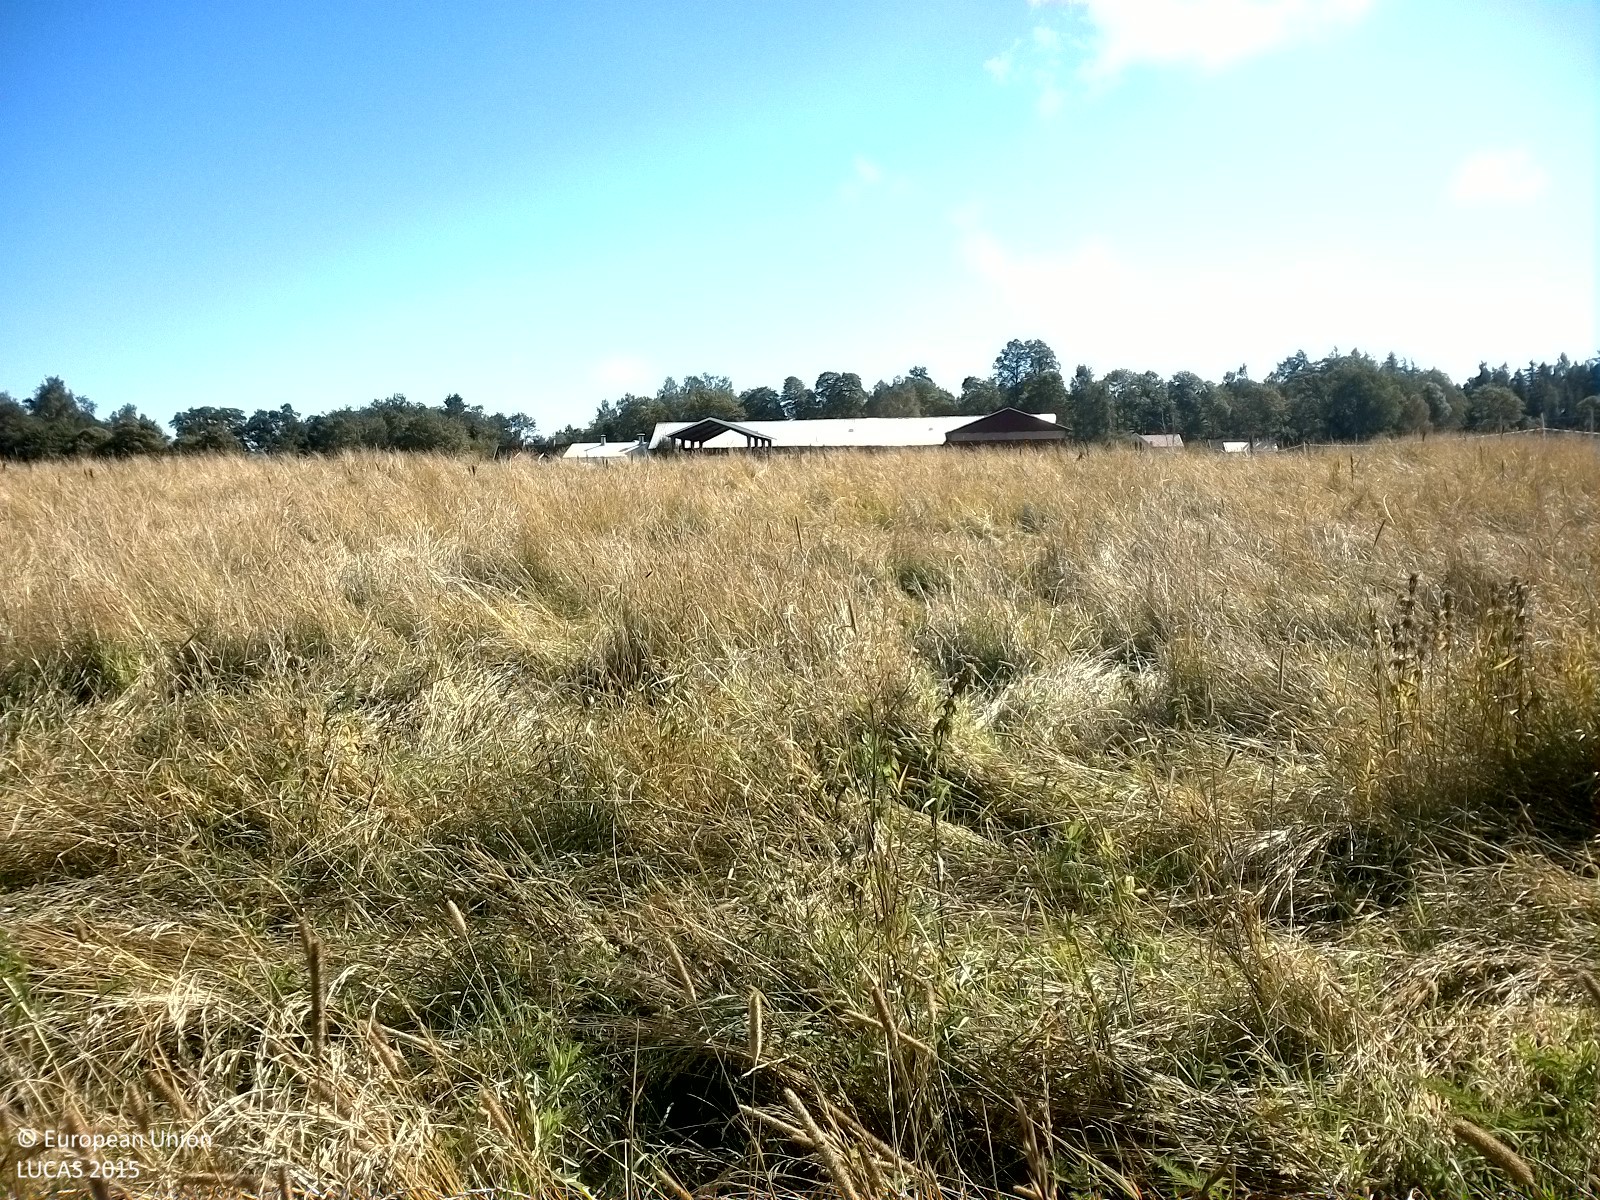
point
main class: Grassland
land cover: Grassland without tree/shrub cover
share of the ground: > 75 %
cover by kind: herbaceous plants 100 %
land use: Agriculture (excluding fallow land and kitchen gardens)
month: August
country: SE
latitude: 59.3678
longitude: 15.0764
